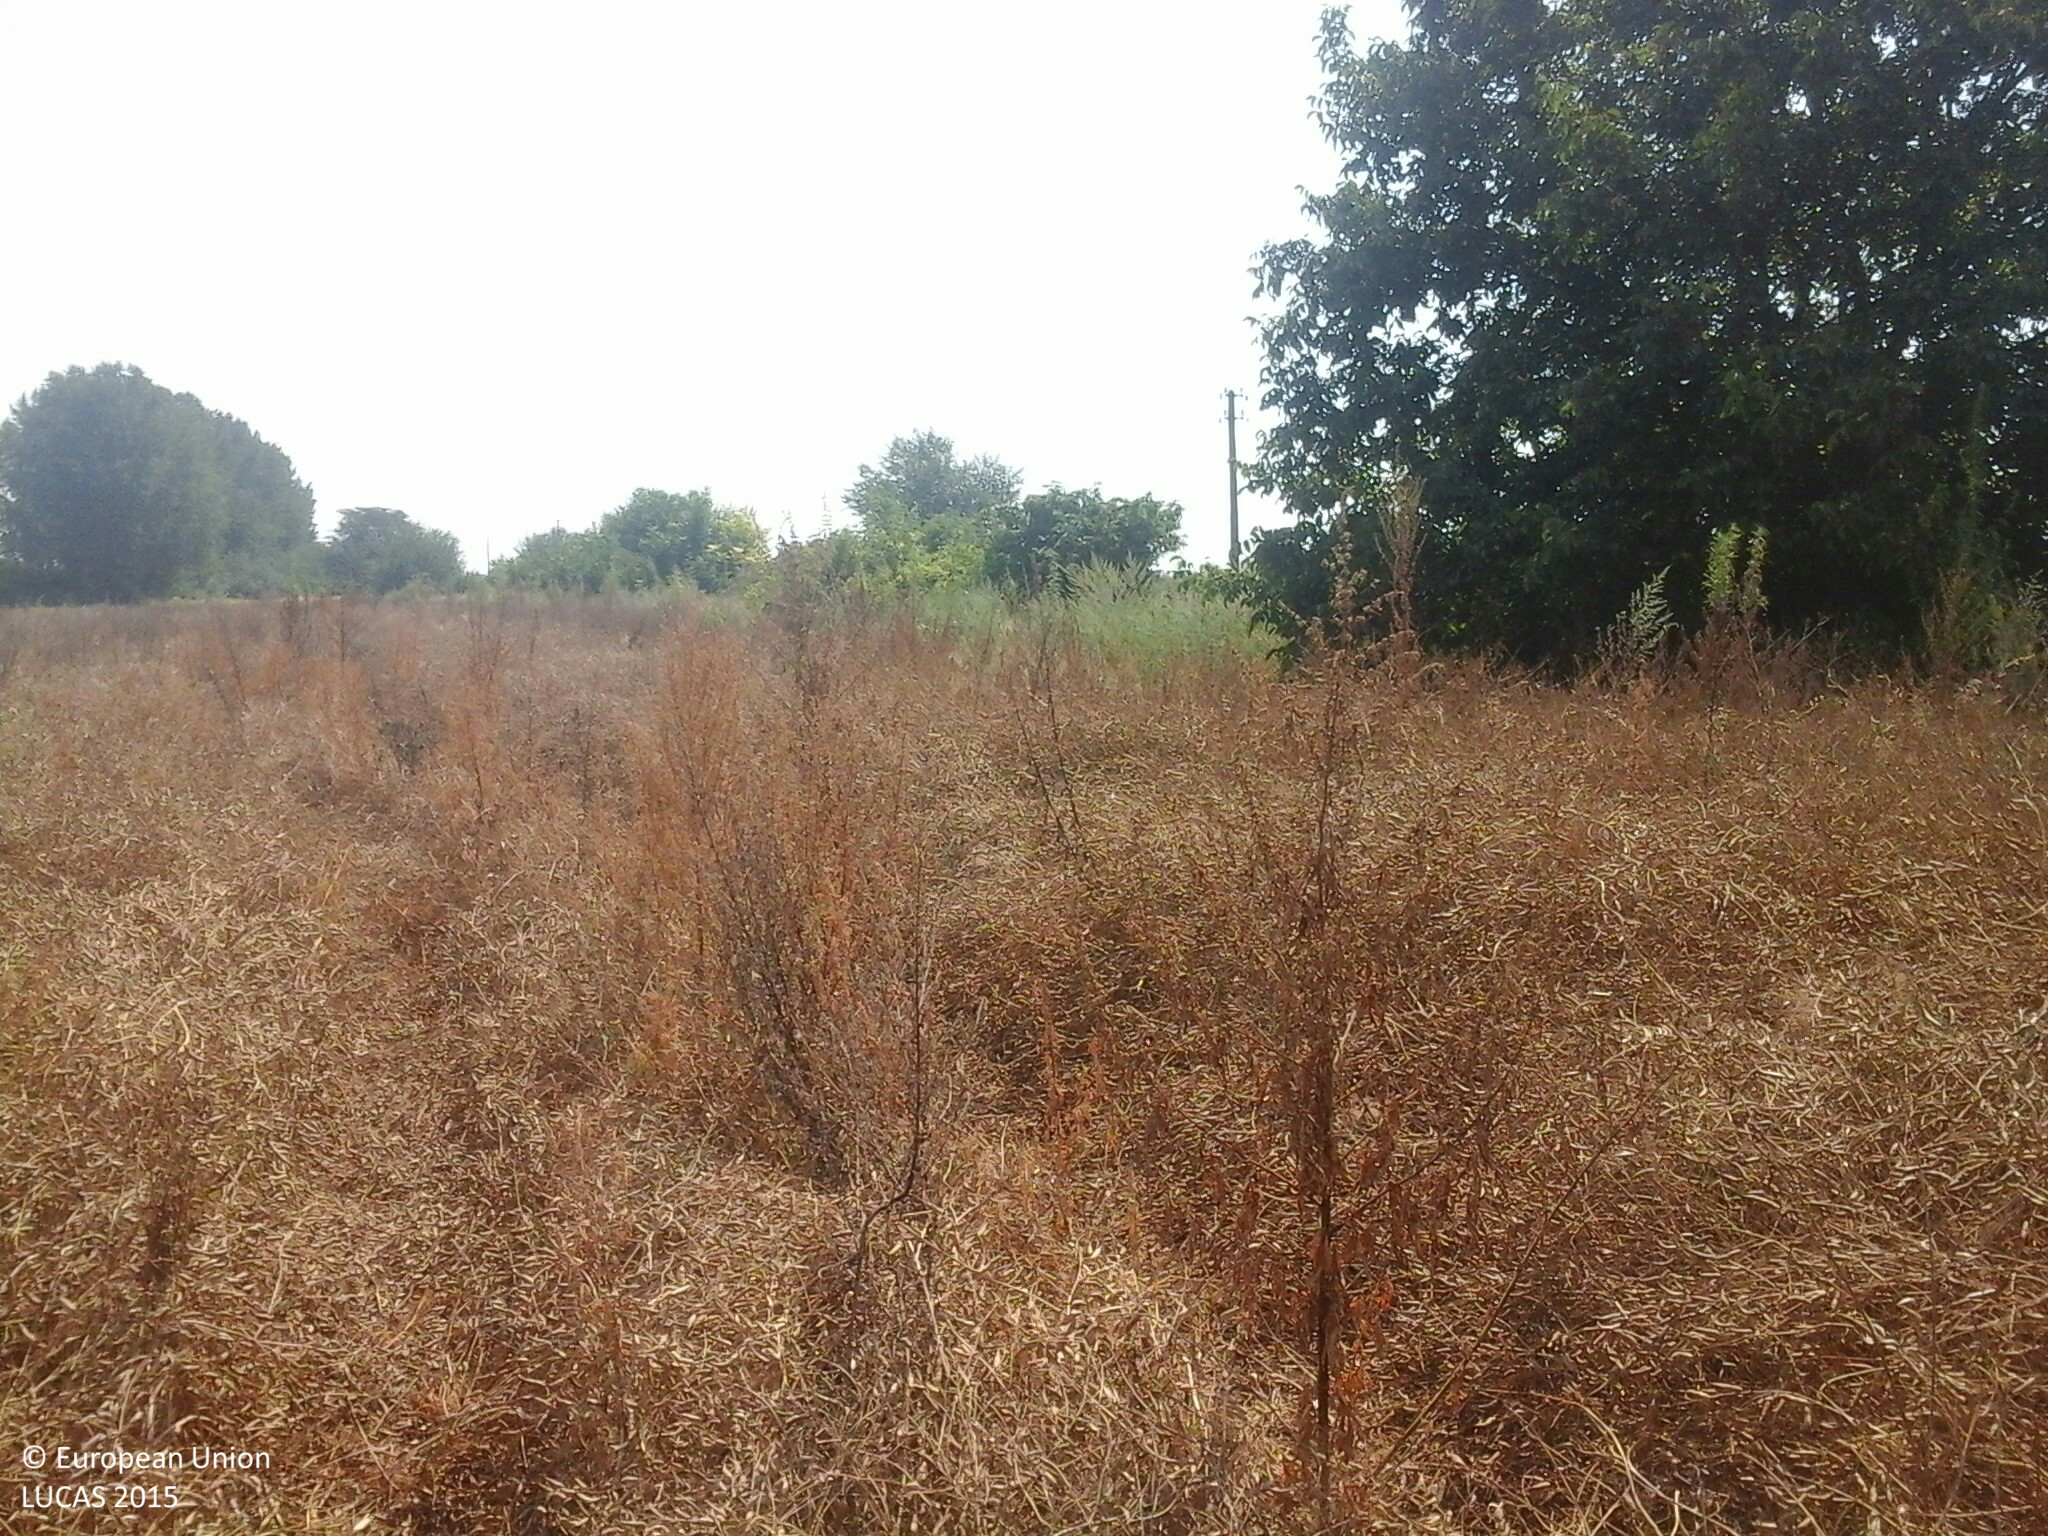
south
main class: Cropland
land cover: Other fibre and oleaginous crops
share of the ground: > 75 %
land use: Agriculture (excluding fallow land and kitchen gardens)
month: August
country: HU
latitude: 46.8737
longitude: 18.1309
